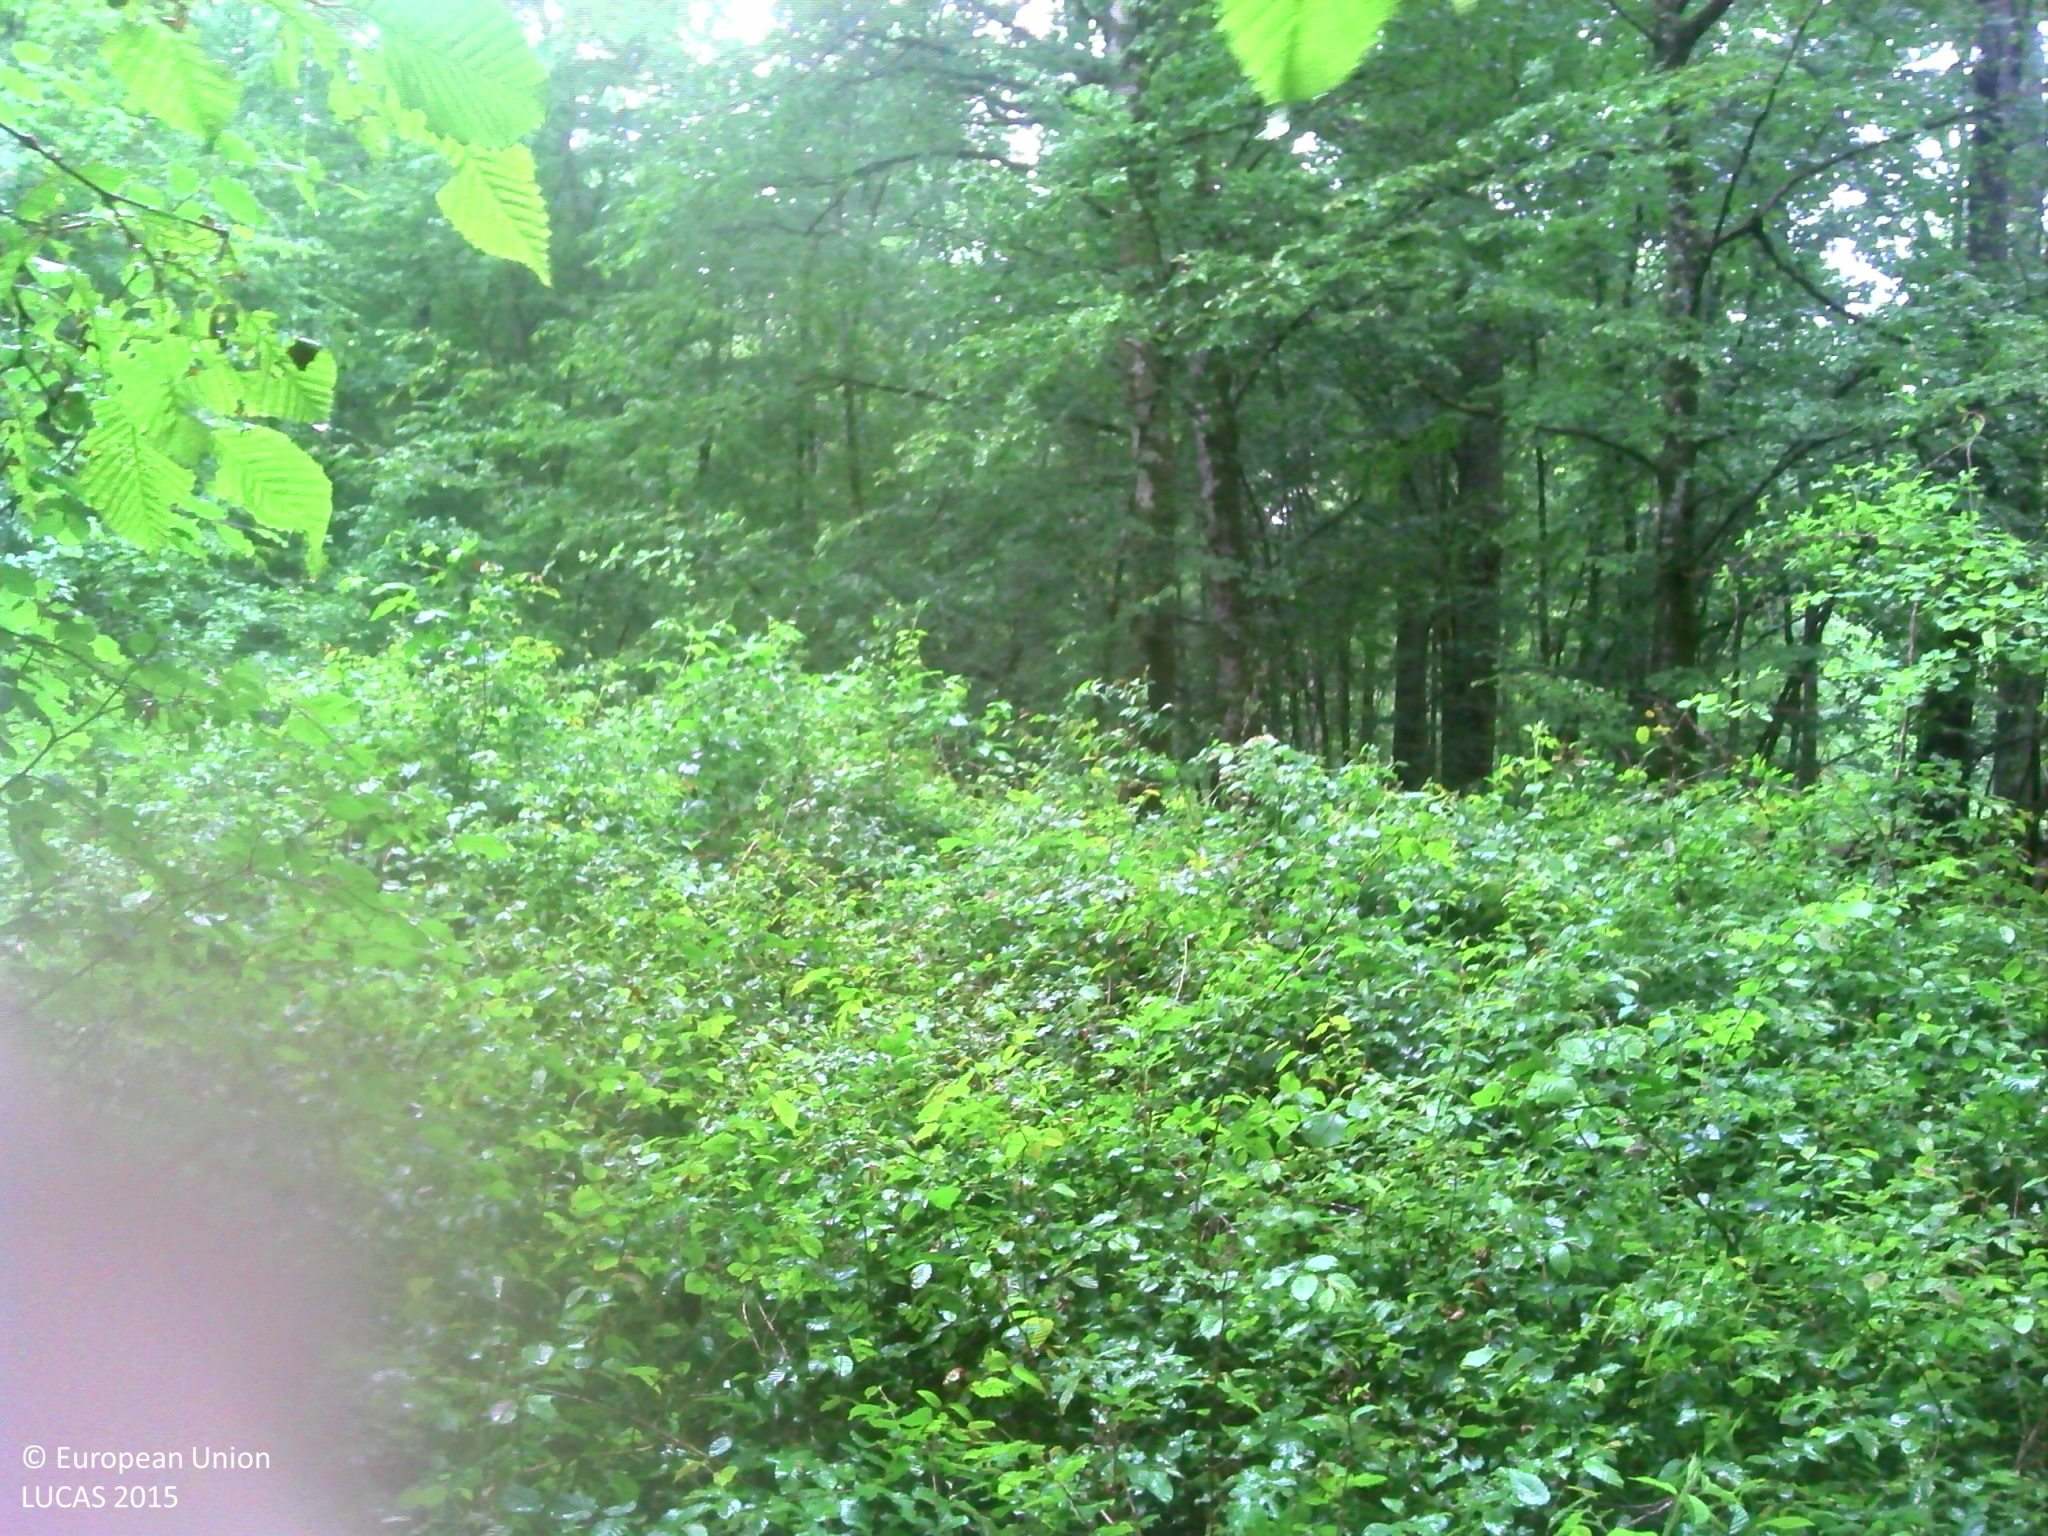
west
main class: Woodland
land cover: Broadleaved woodland
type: mesophytic deciduous forest
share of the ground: > 75 %
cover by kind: broadleaved forest trees 90 %, herbaceous plants 10 %
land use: Forestry
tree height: > 5 m
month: May
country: FR
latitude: 48.6121
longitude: 4.9389
